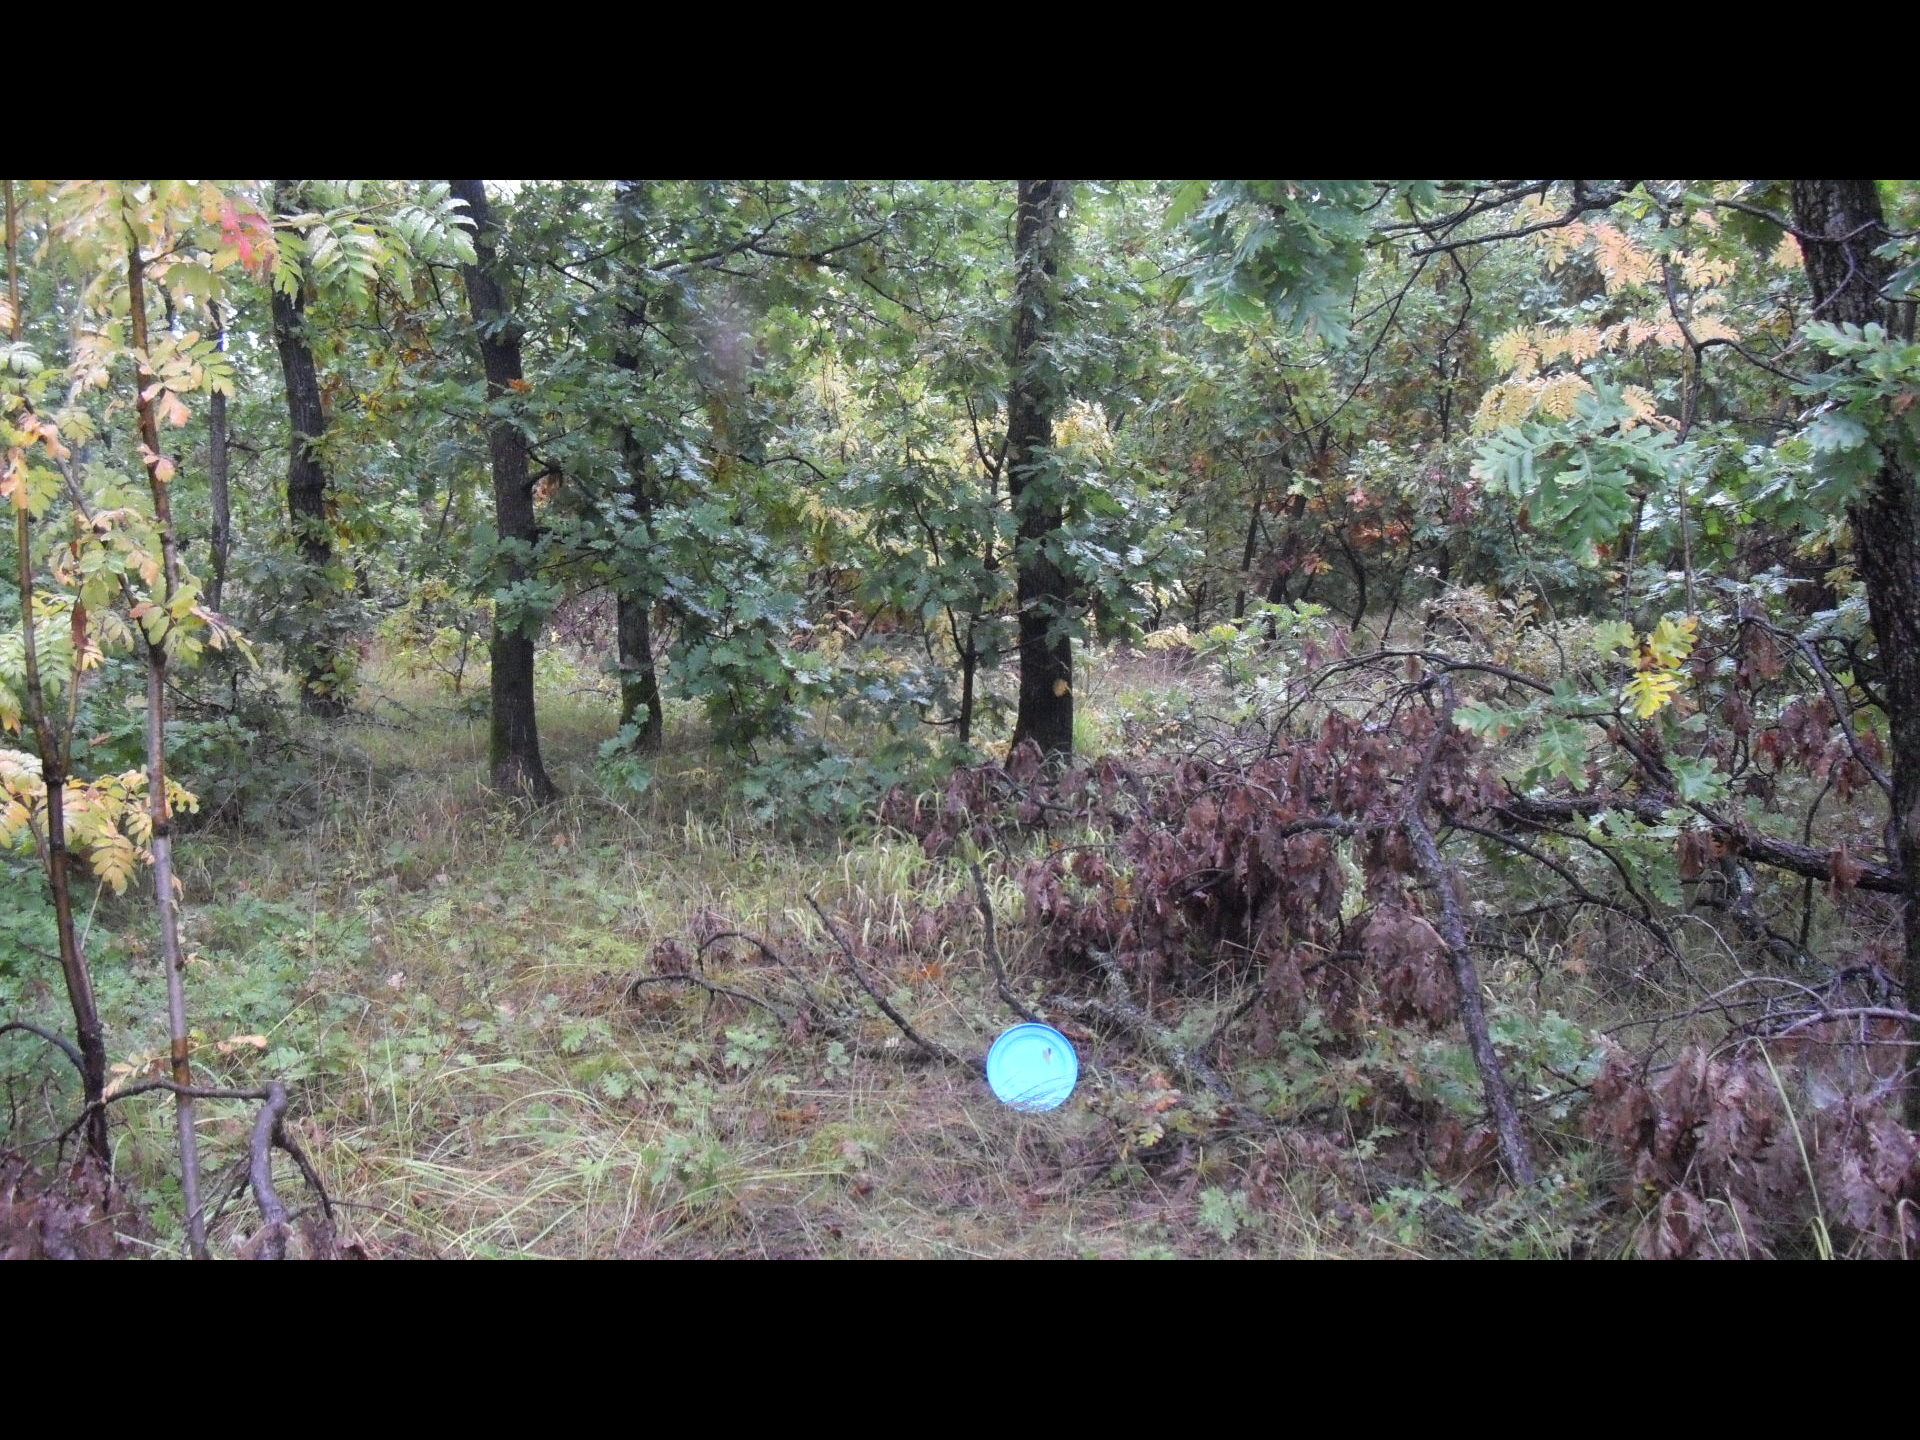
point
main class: Woodland
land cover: Broadleaved woodland
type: mesophytic deciduous forest
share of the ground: > 75 %
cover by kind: broadleaved forest trees 80 %, herbaceous plants 20 %
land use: Forestry
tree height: > 5 m
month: October
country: BG
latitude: 43.7062
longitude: 22.6046
